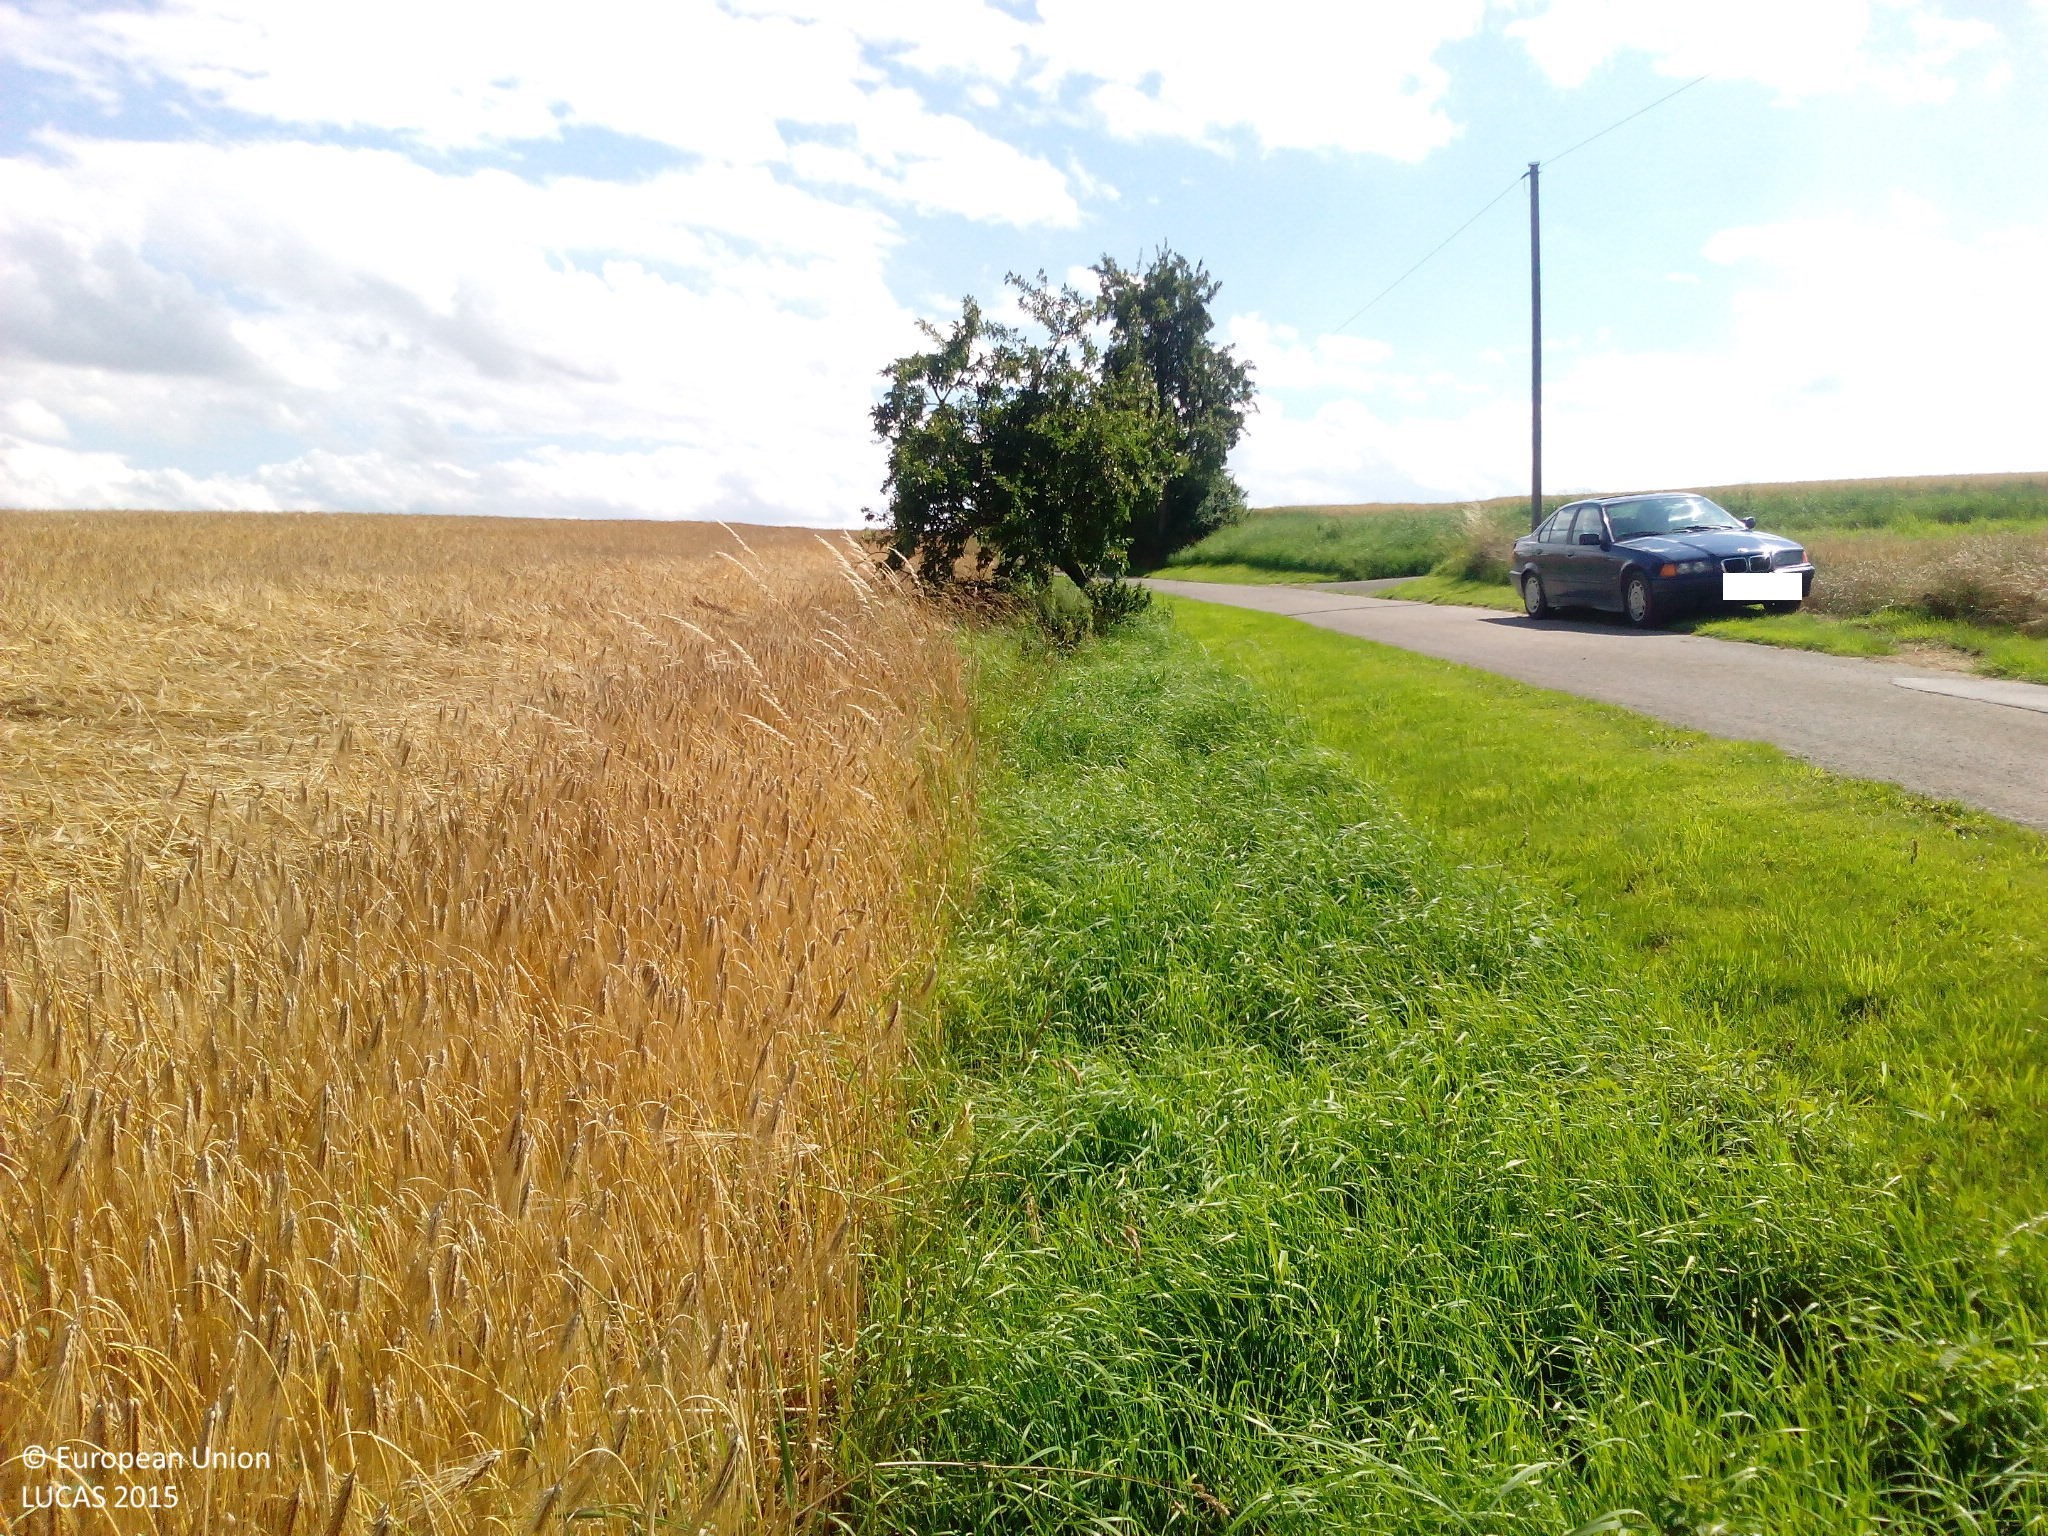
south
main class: Cropland
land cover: Barley
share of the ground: > 75 %
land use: Agriculture (excluding fallow land and kitchen gardens)
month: July
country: DE
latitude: 51.6733
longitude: 9.1471
